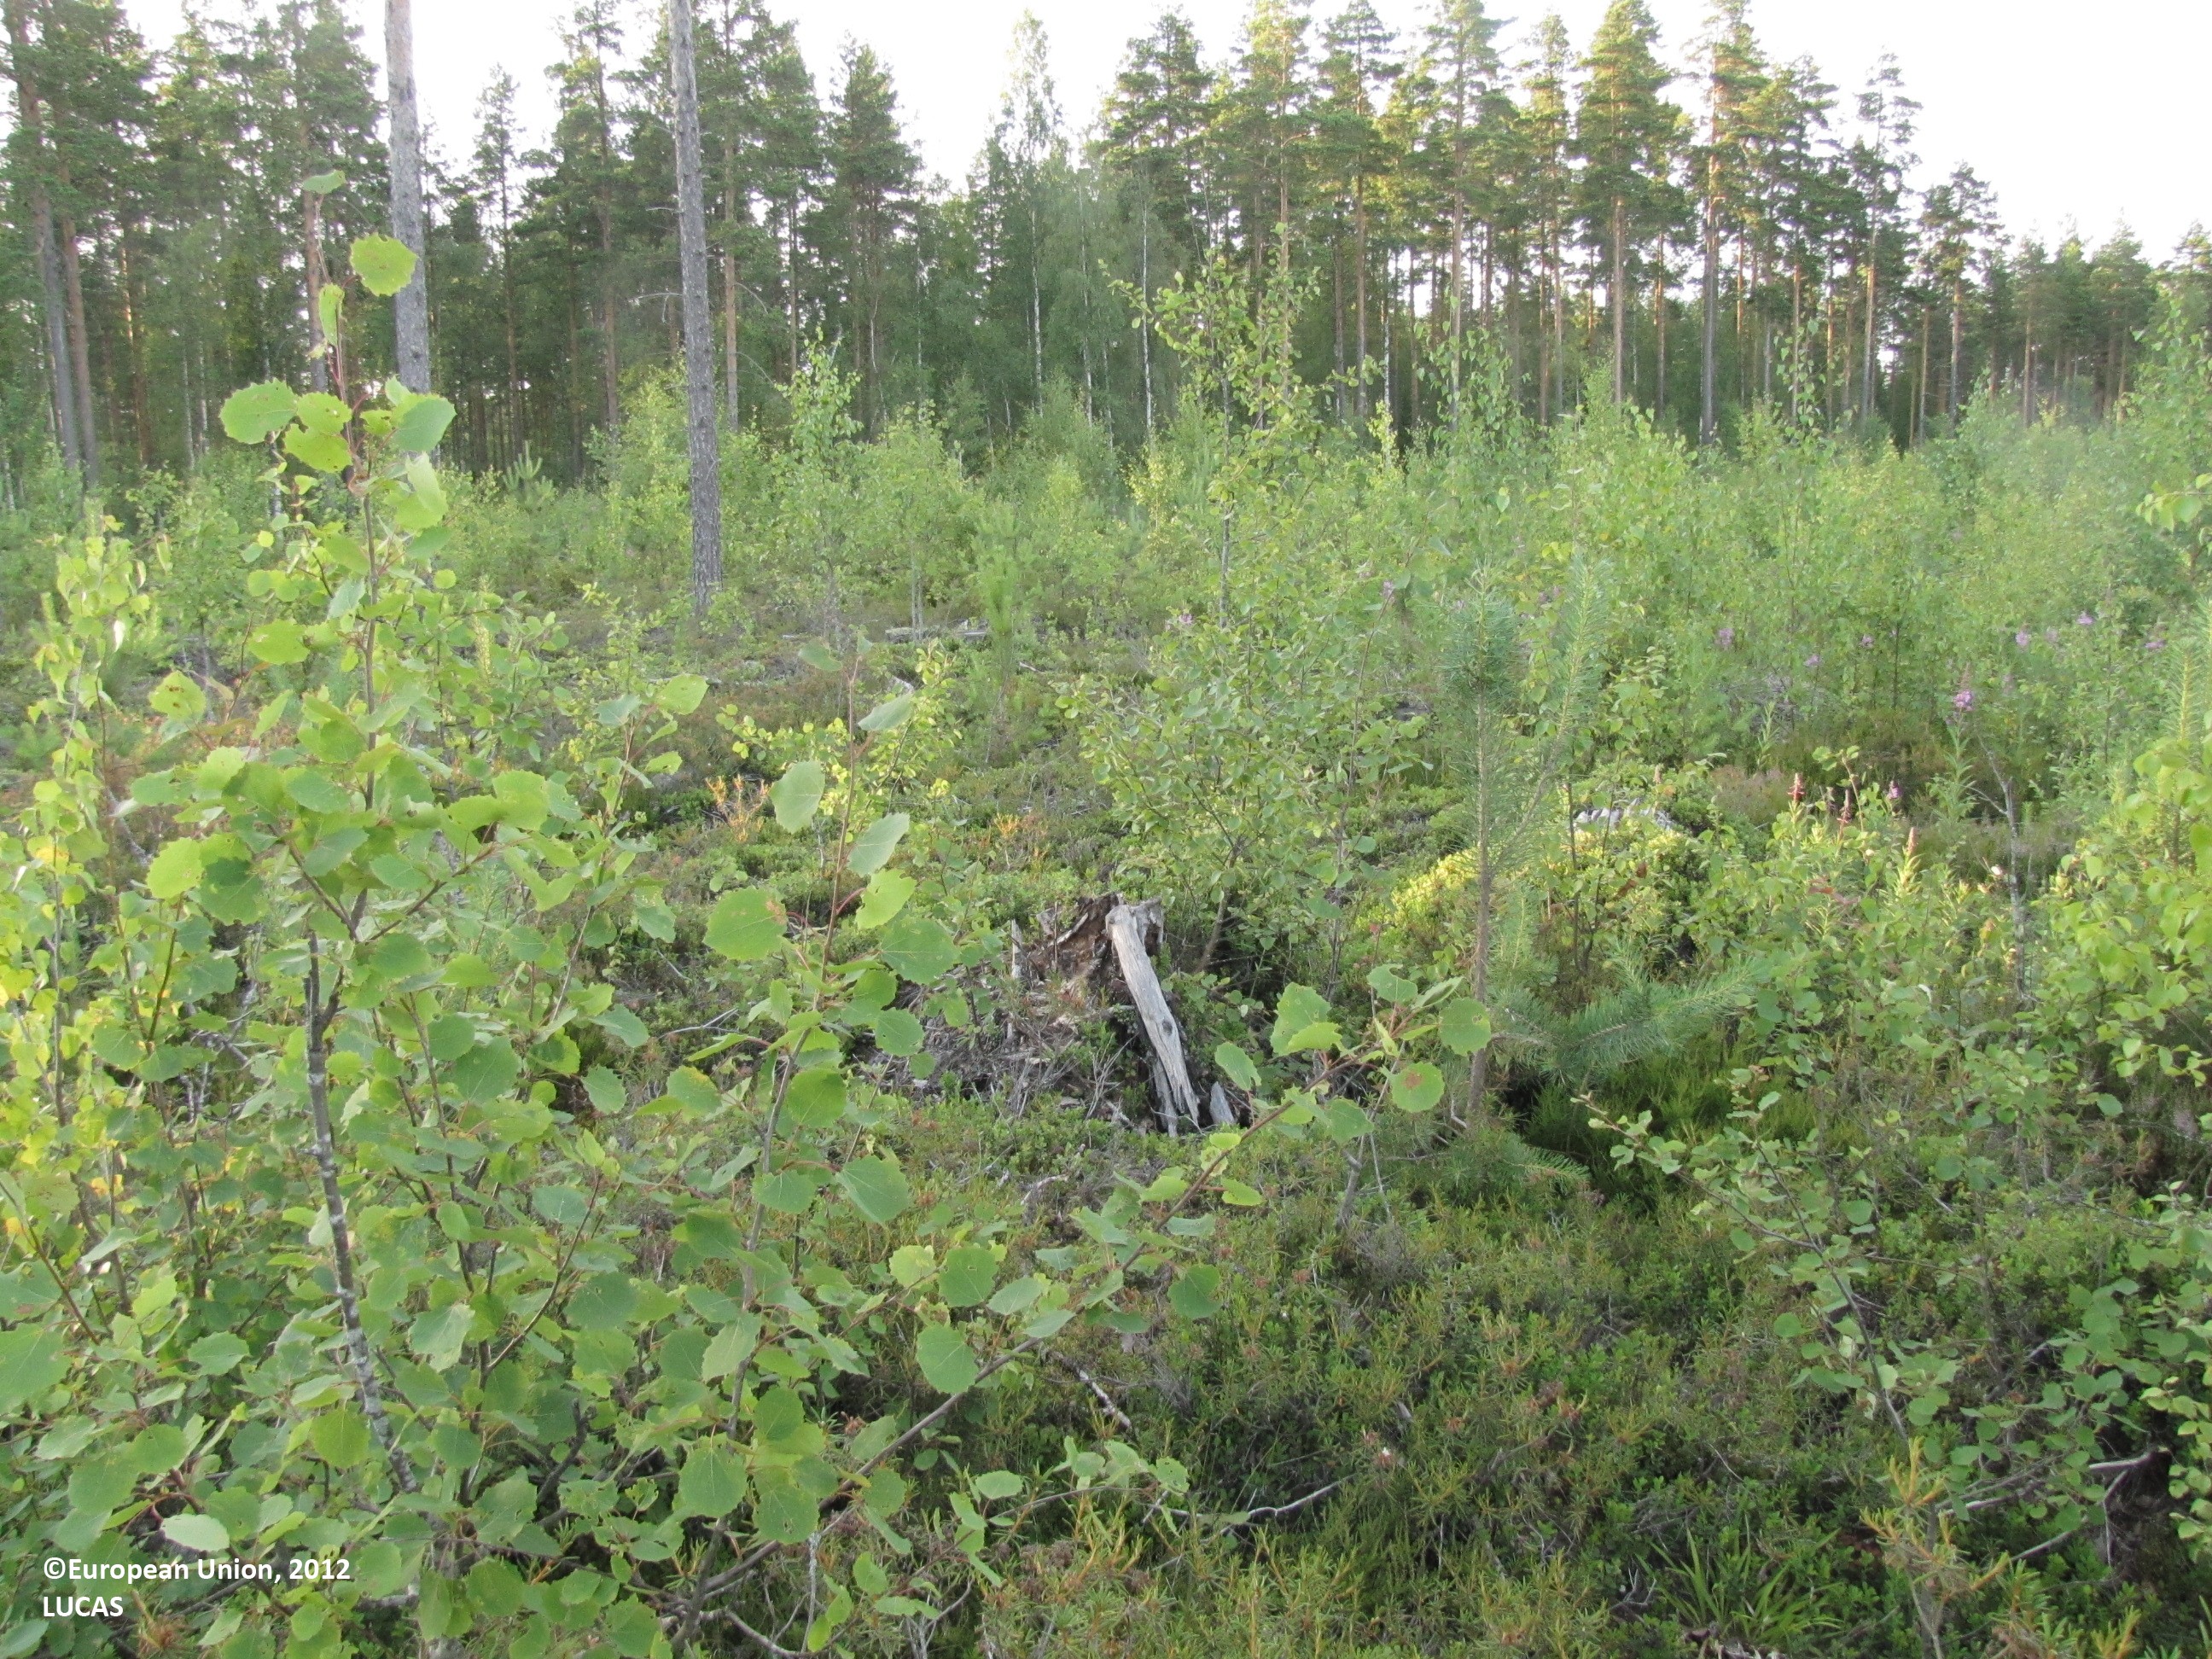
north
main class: Woodland
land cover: Broadleaved woodland
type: mire and swamp forests
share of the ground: 50 - 75 %
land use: Forestry
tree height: < 5 m
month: July
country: FI
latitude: 62.5675
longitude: 23.3174
